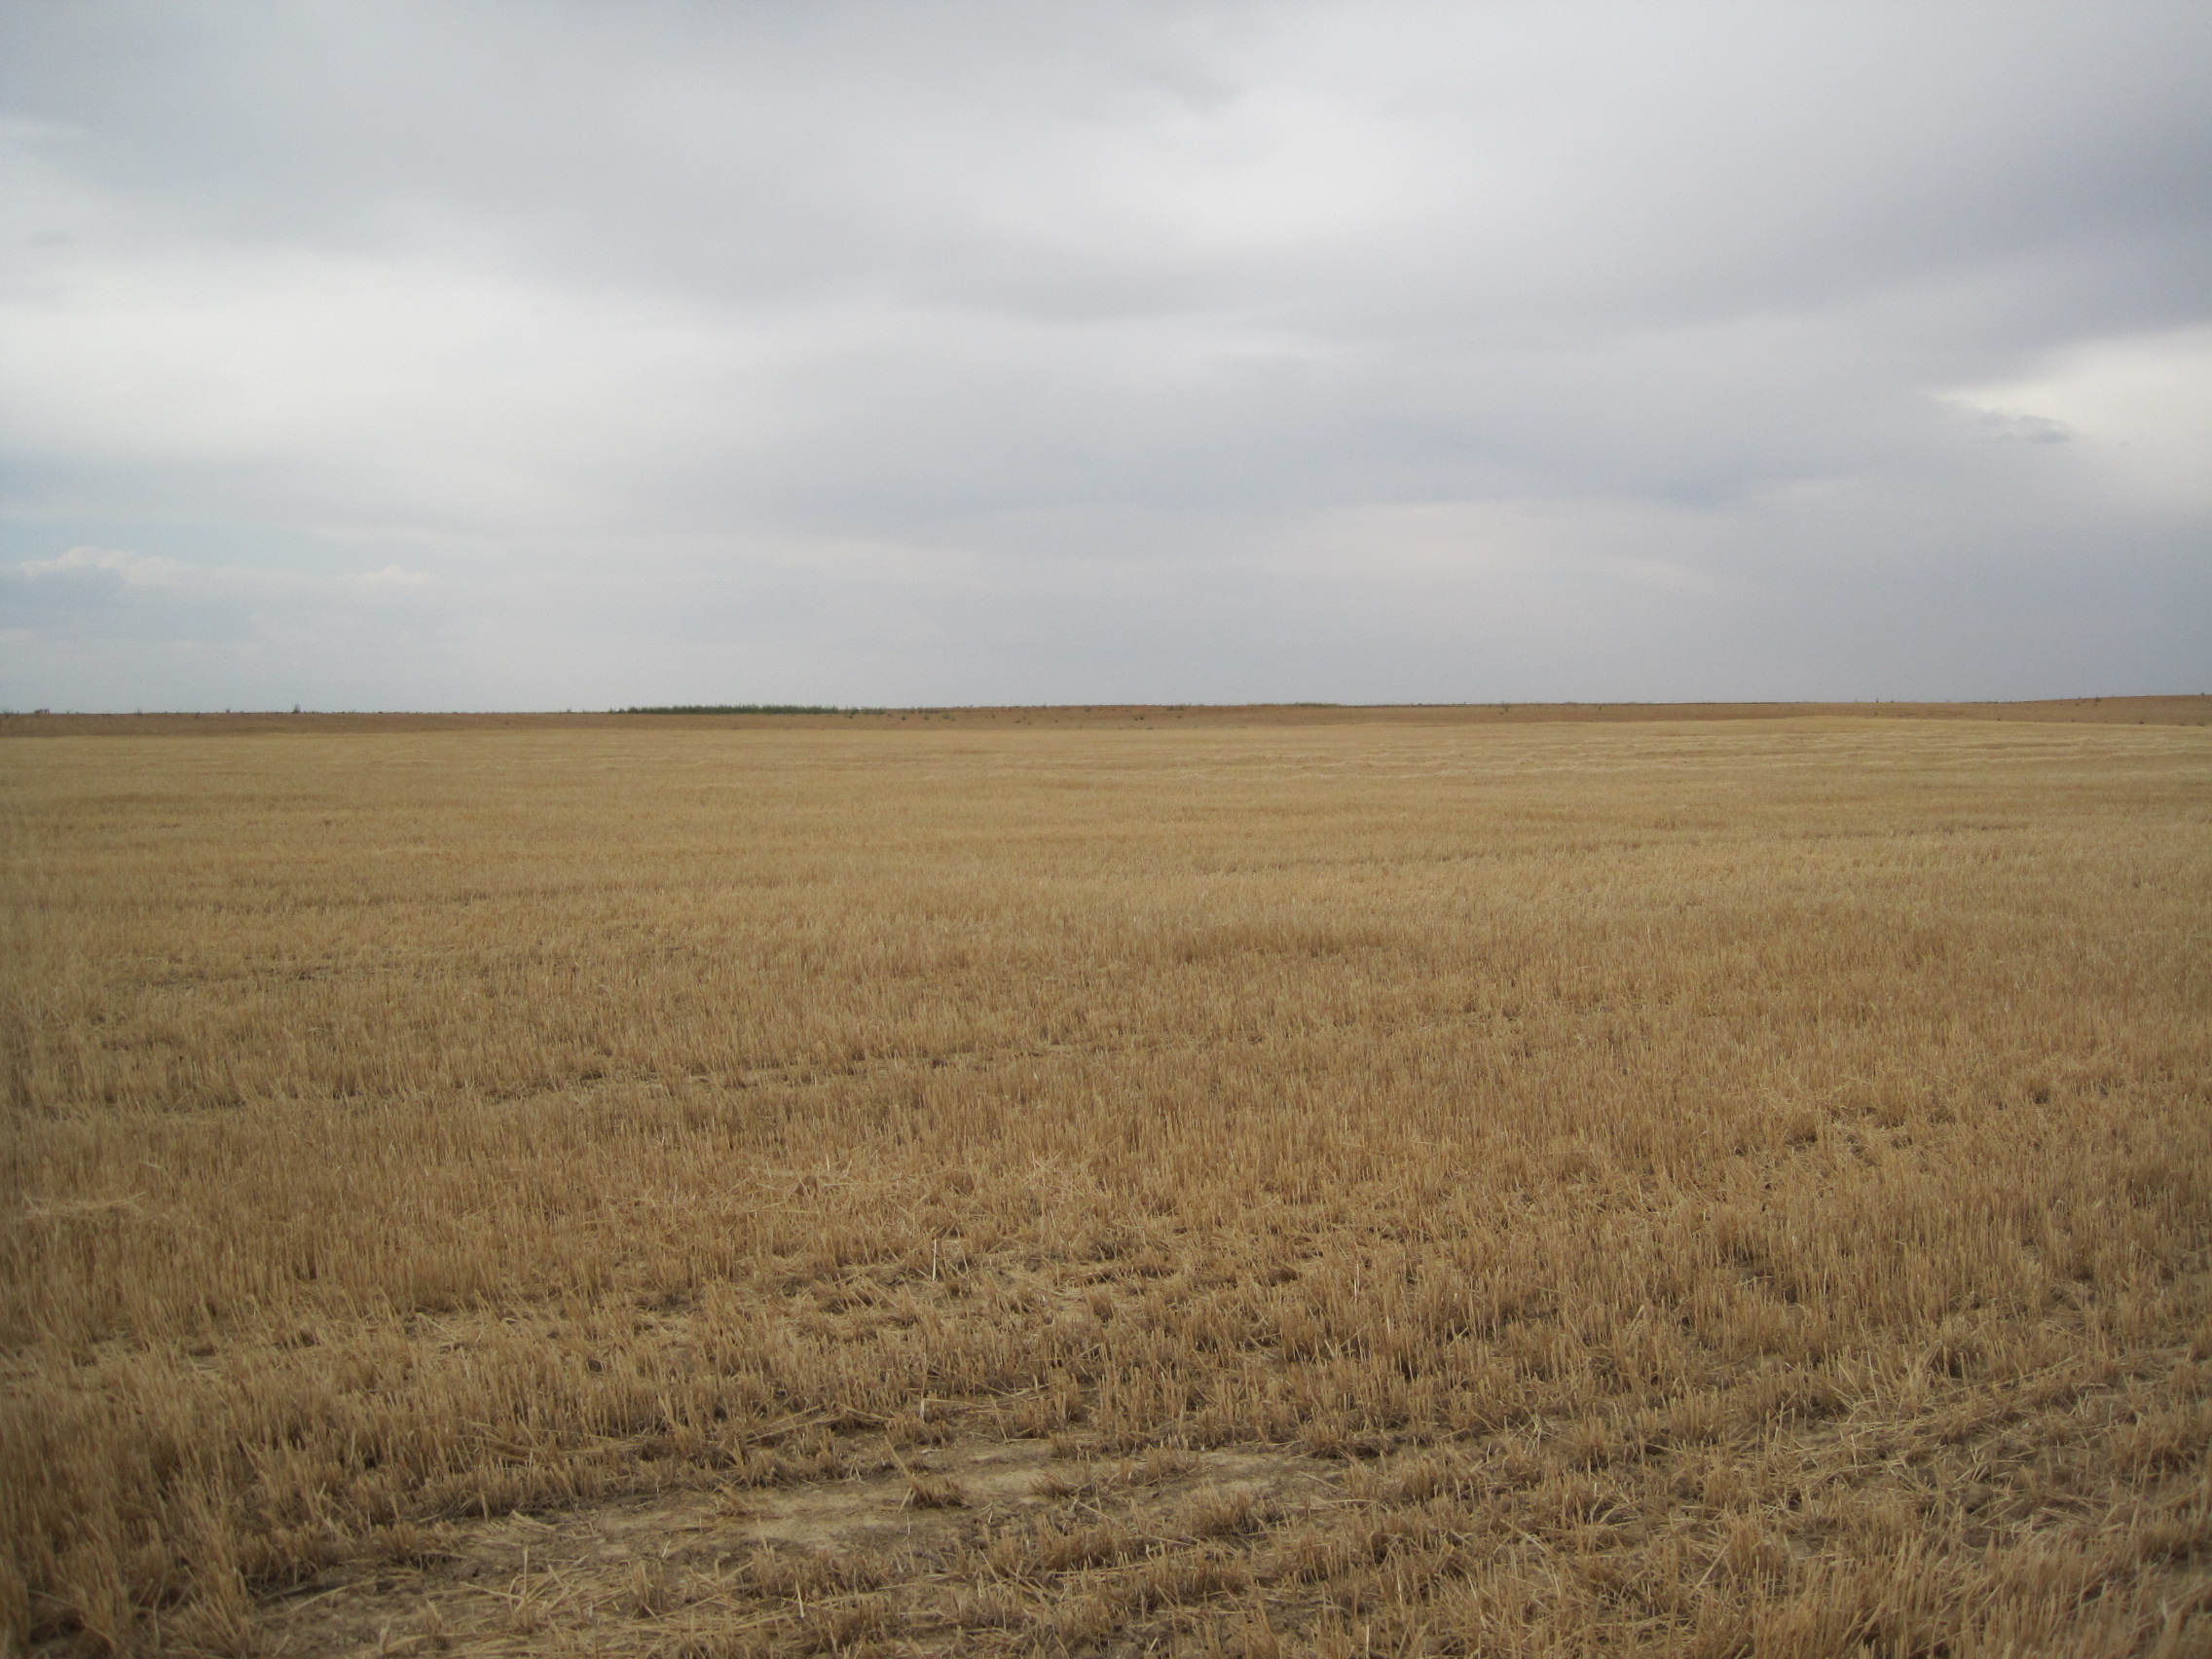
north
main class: Cropland
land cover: Barley
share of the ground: < 10 %
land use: Agriculture (excluding fallow land and kitchen gardens)
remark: Harvested field
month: July
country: ES
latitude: 41.8036
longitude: -5.6018
